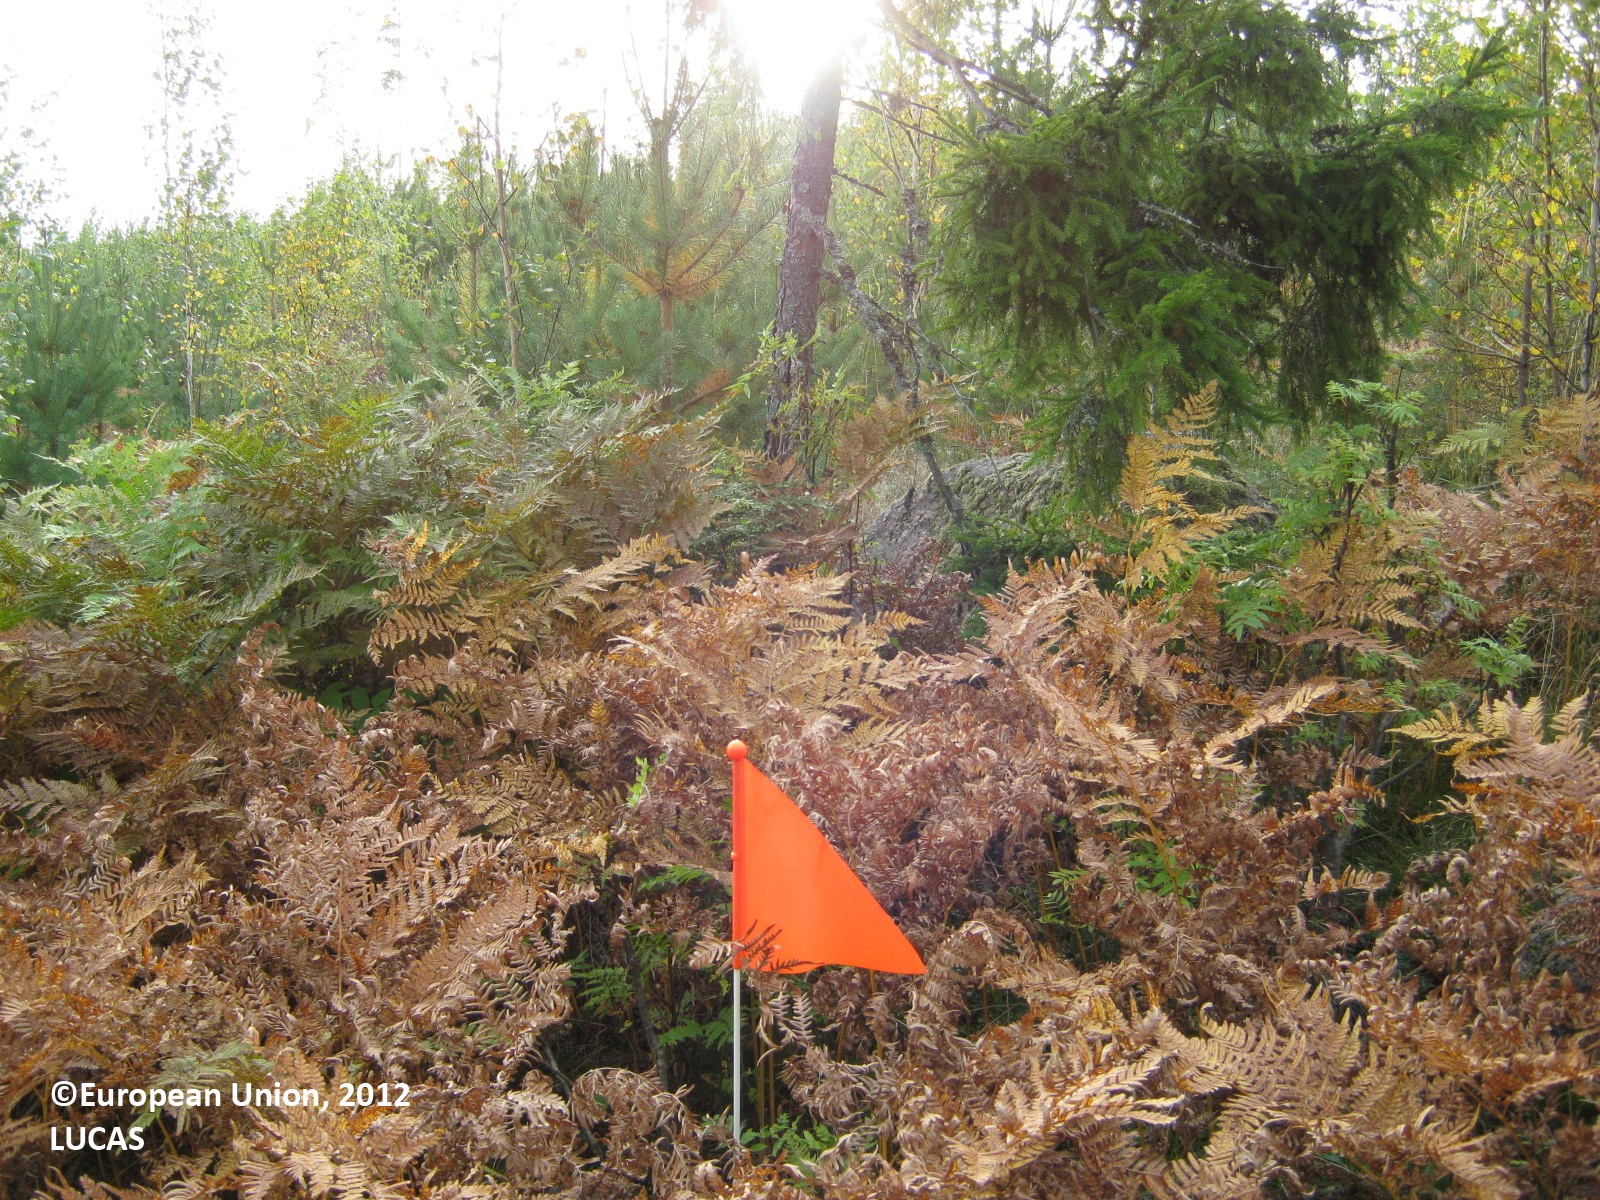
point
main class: Woodland
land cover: Pine dominated mixed woodland
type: boreal forest
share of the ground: > 75 %
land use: Forestry
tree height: < 5 m
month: September
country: FI
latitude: 60.7975
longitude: 27.7772
